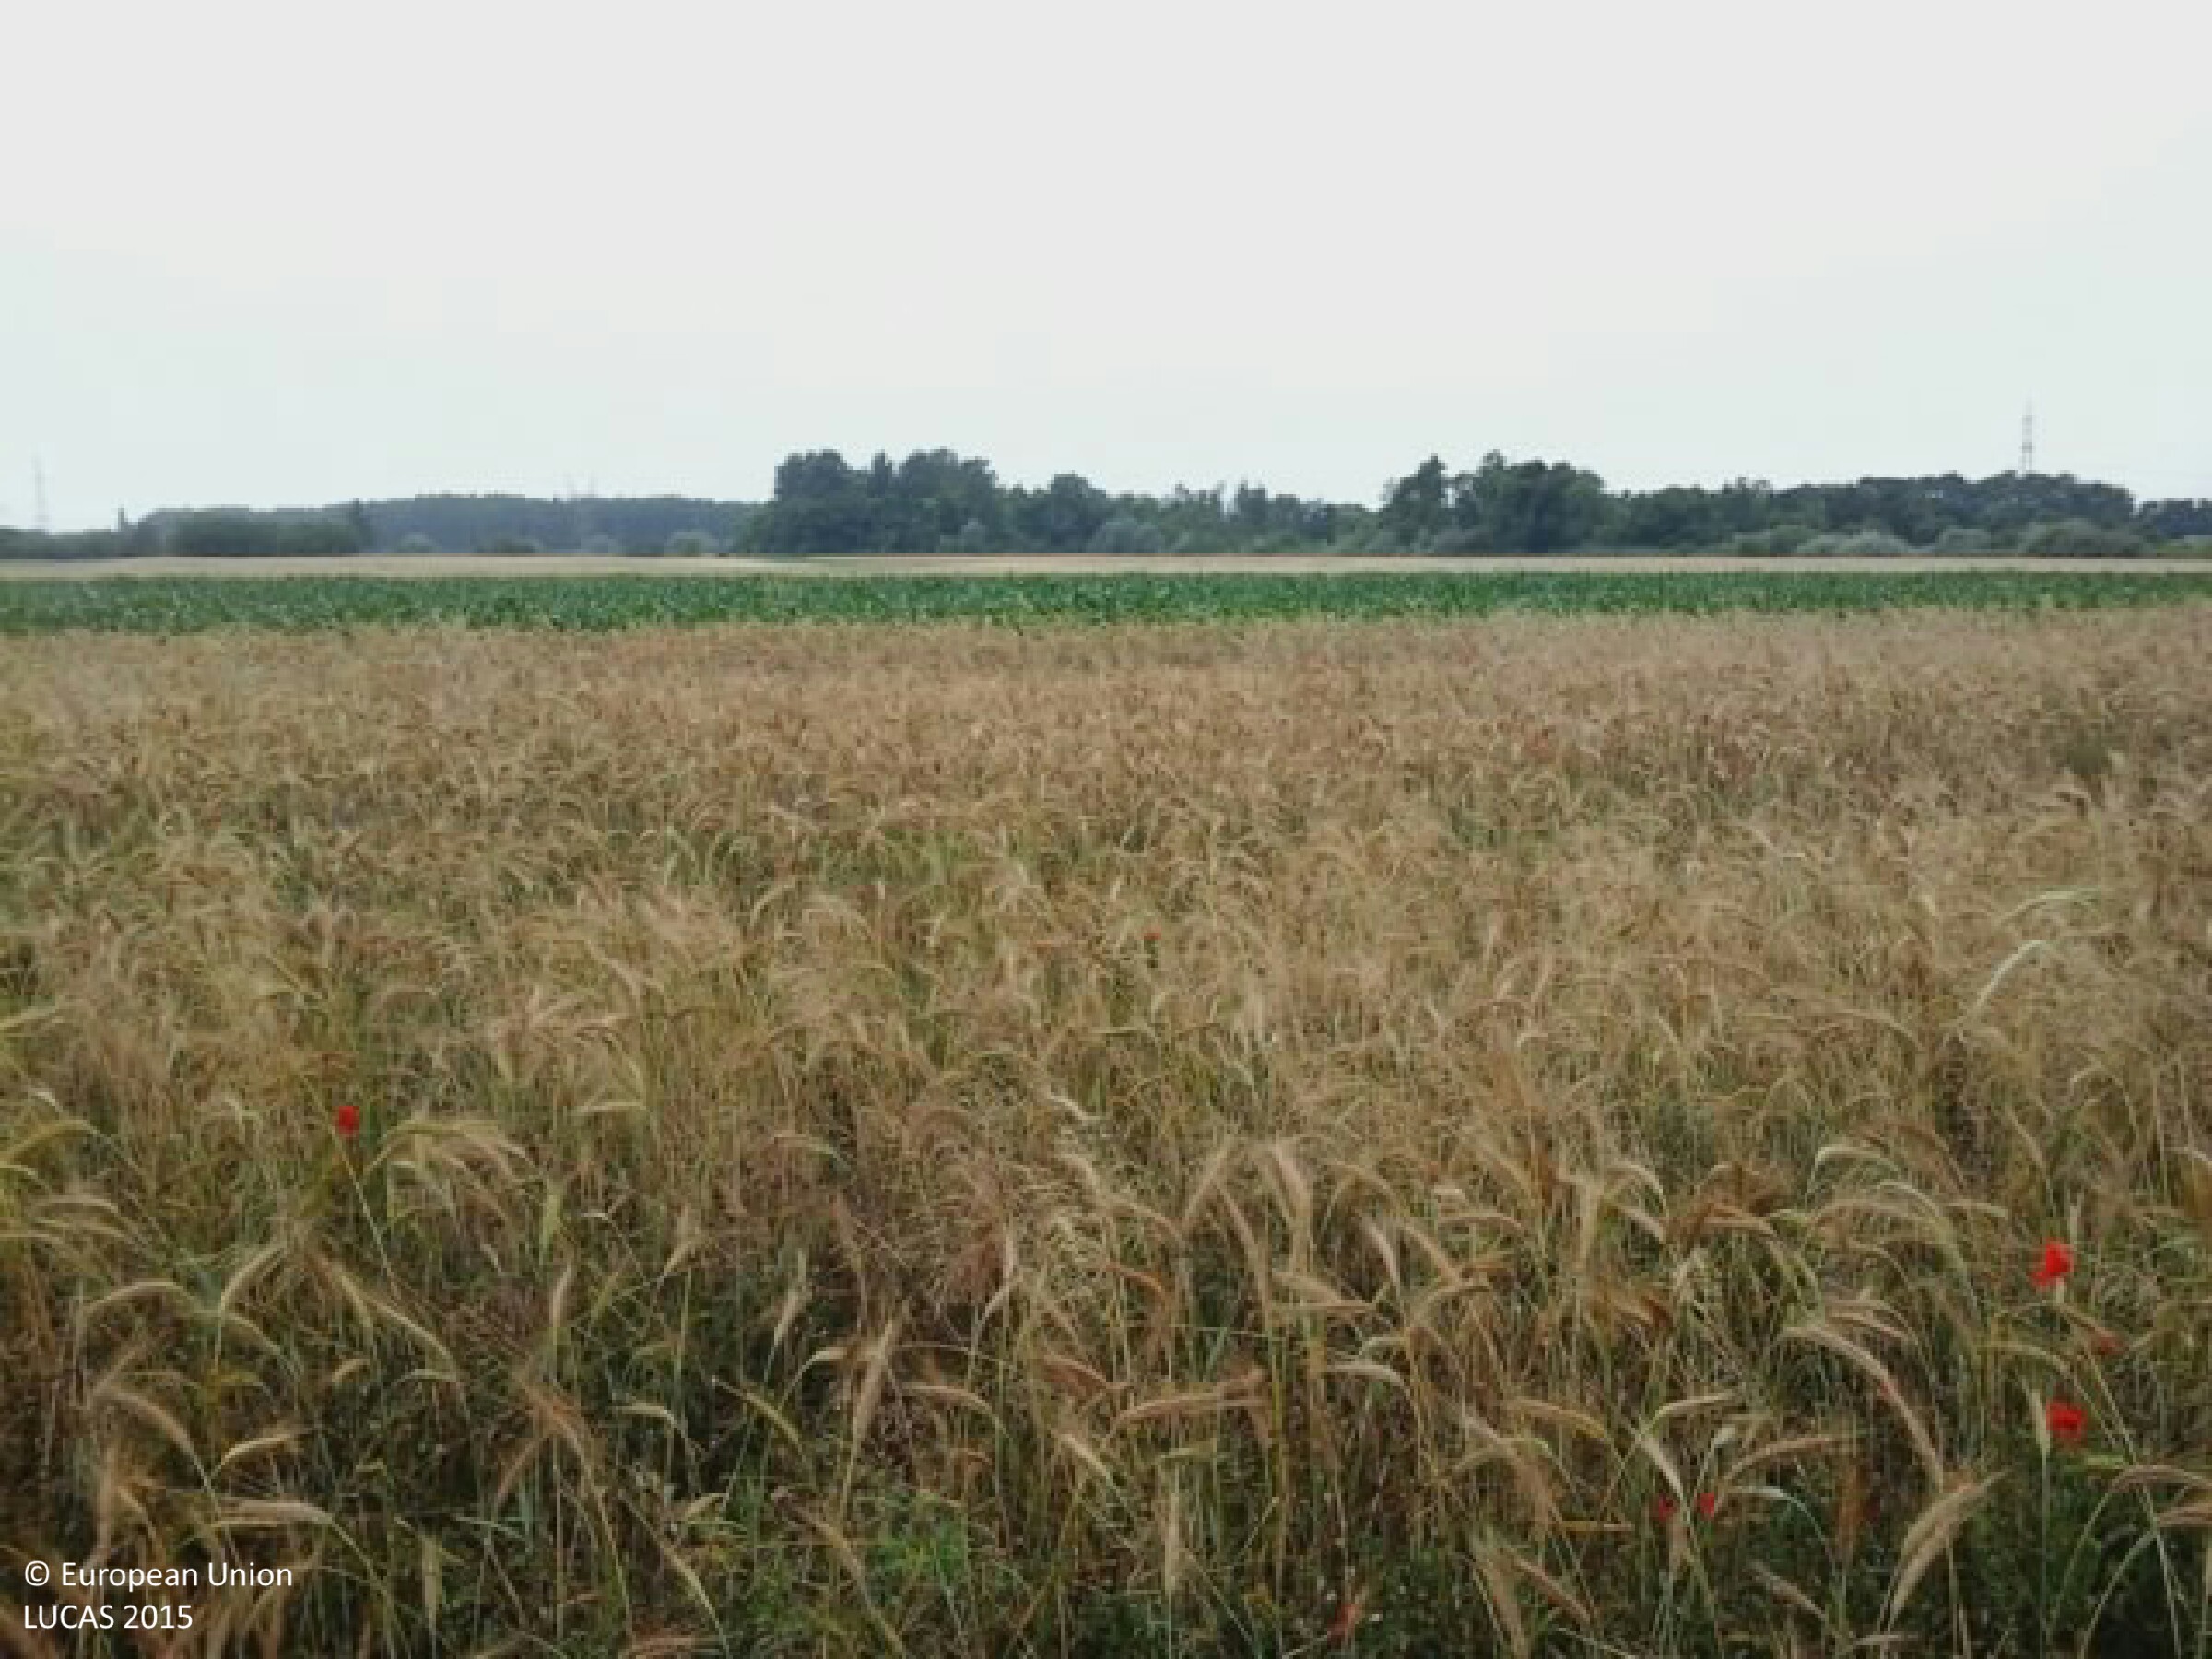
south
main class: Cropland
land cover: Common wheat
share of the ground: > 75 %
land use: Agriculture (excluding fallow land and kitchen gardens)
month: June
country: HU
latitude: 46.3980
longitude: 20.1018
